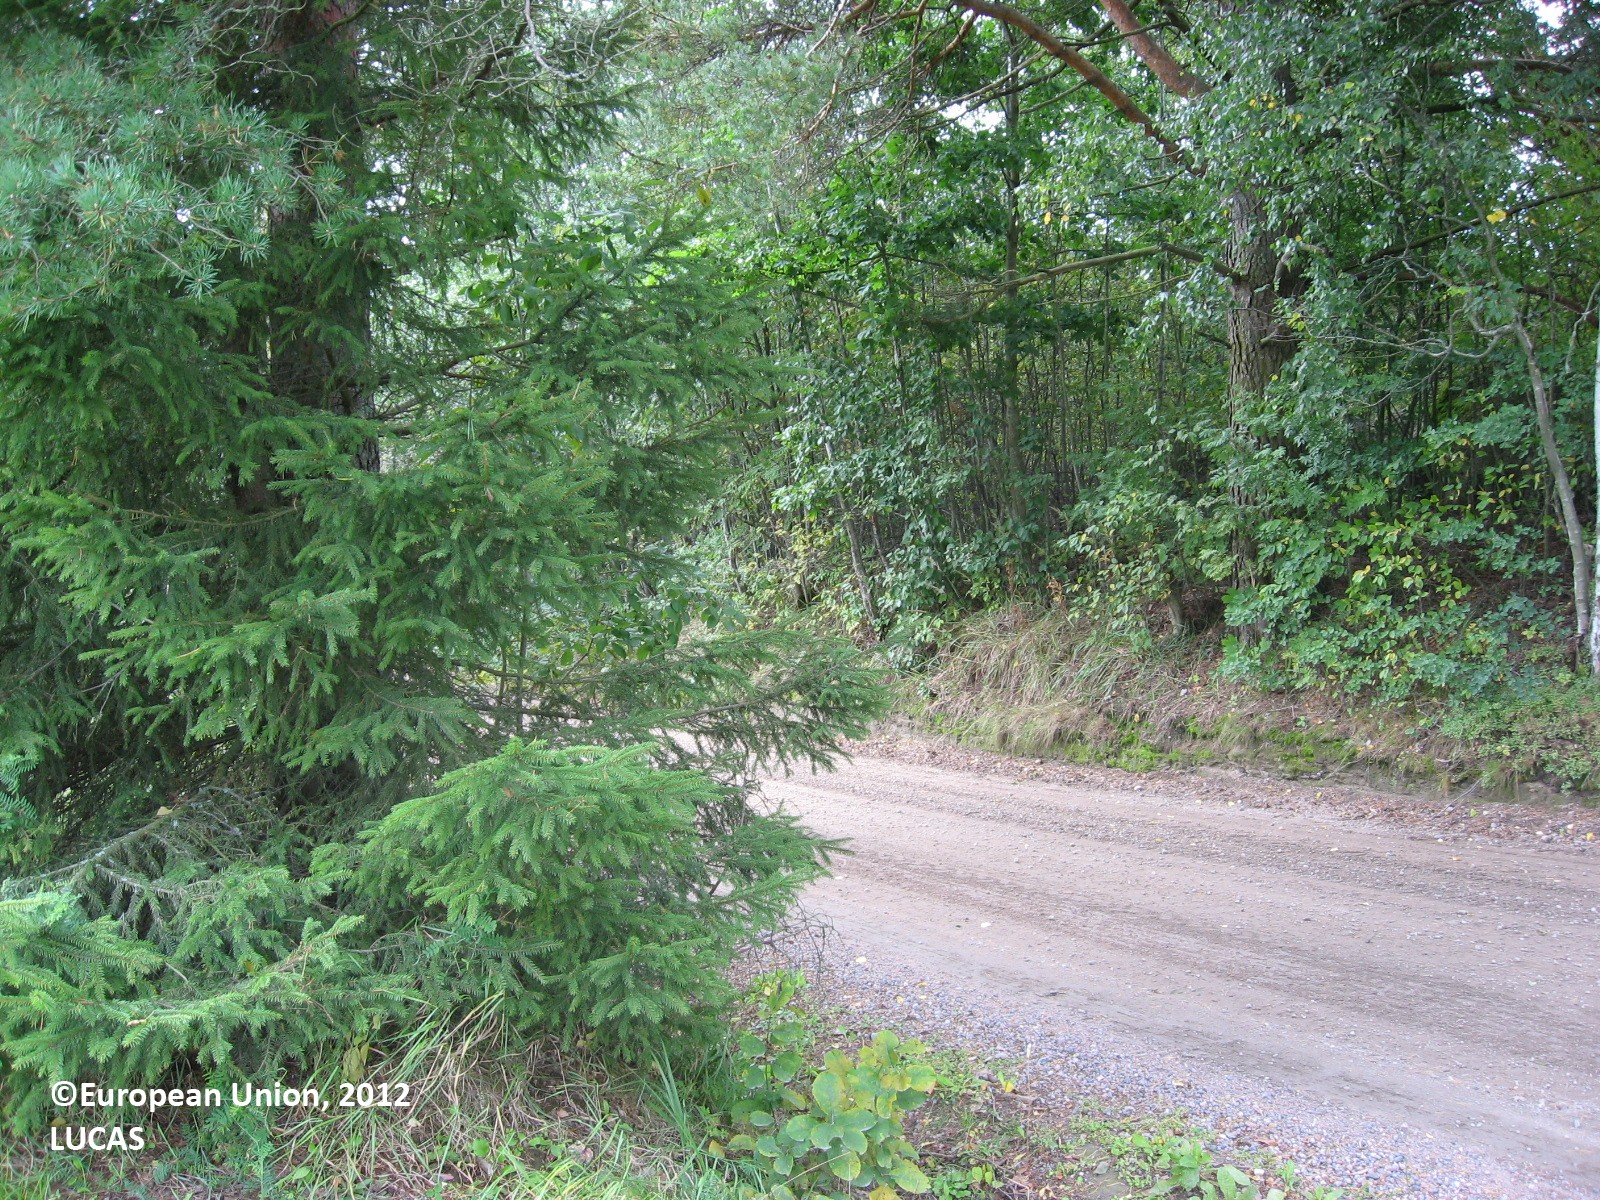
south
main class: Cropland
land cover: Temporary grasslands
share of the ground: > 75 %
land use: Agriculture (excluding fallow land and kitchen gardens)
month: September
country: FI
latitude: 60.8506
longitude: 25.2679
